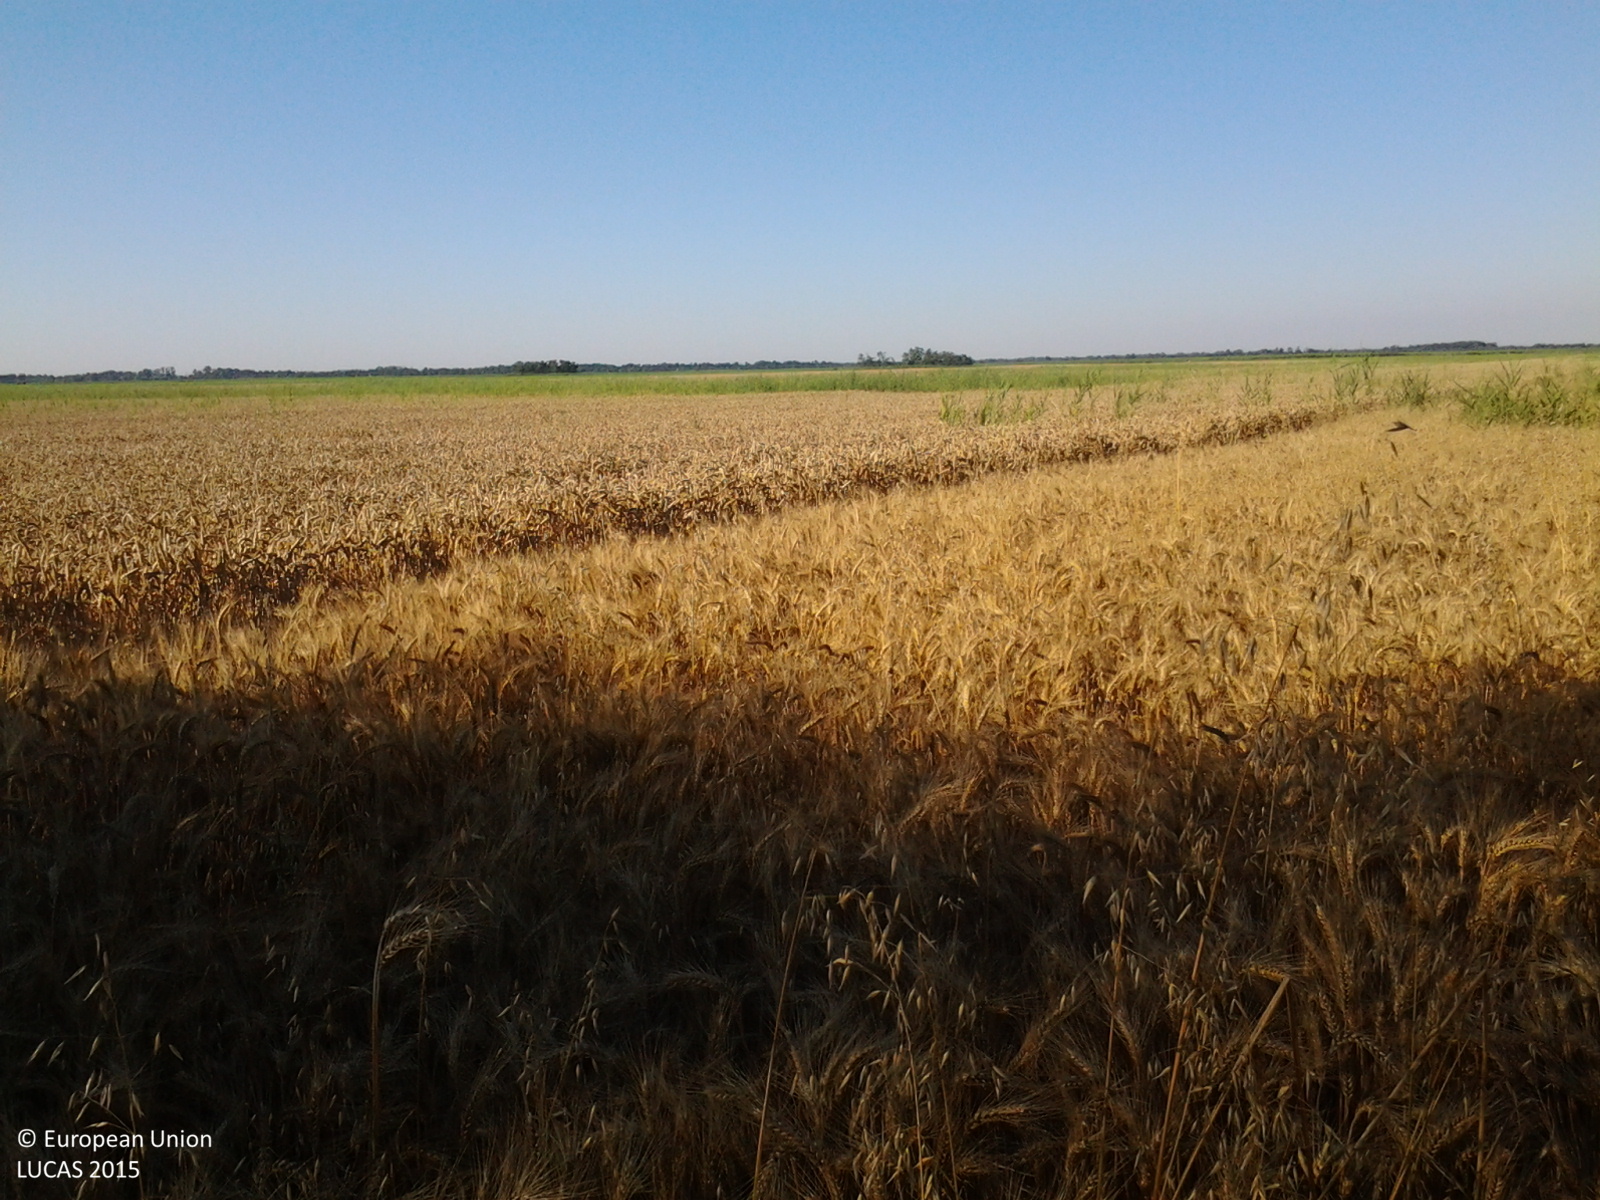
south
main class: Cropland
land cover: Common wheat
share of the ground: > 75 %
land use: Agriculture (excluding fallow land and kitchen gardens)
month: July
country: HU
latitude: 47.0473
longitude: 20.5200
